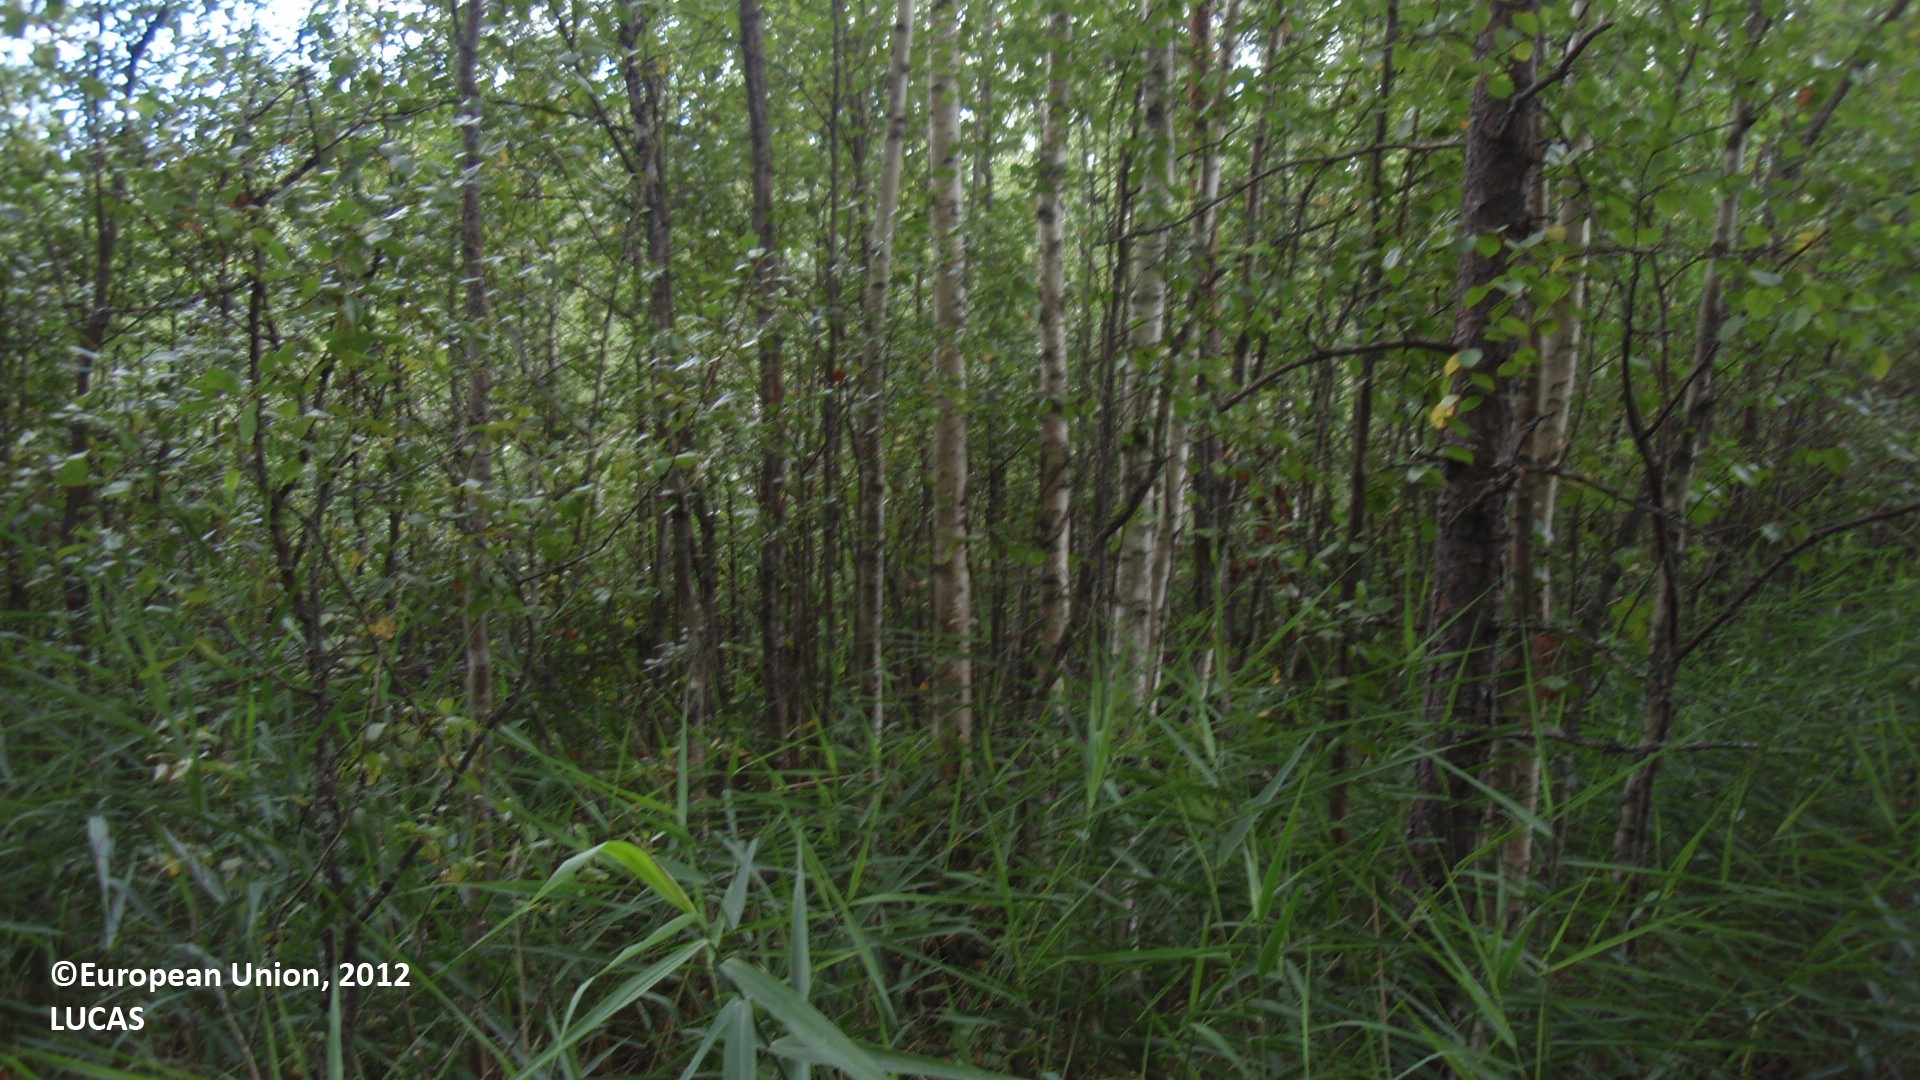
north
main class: Woodland
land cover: Broadleaved woodland
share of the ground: > 75 %
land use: Forestry
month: August
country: FI
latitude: 61.1275
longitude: 27.8098
